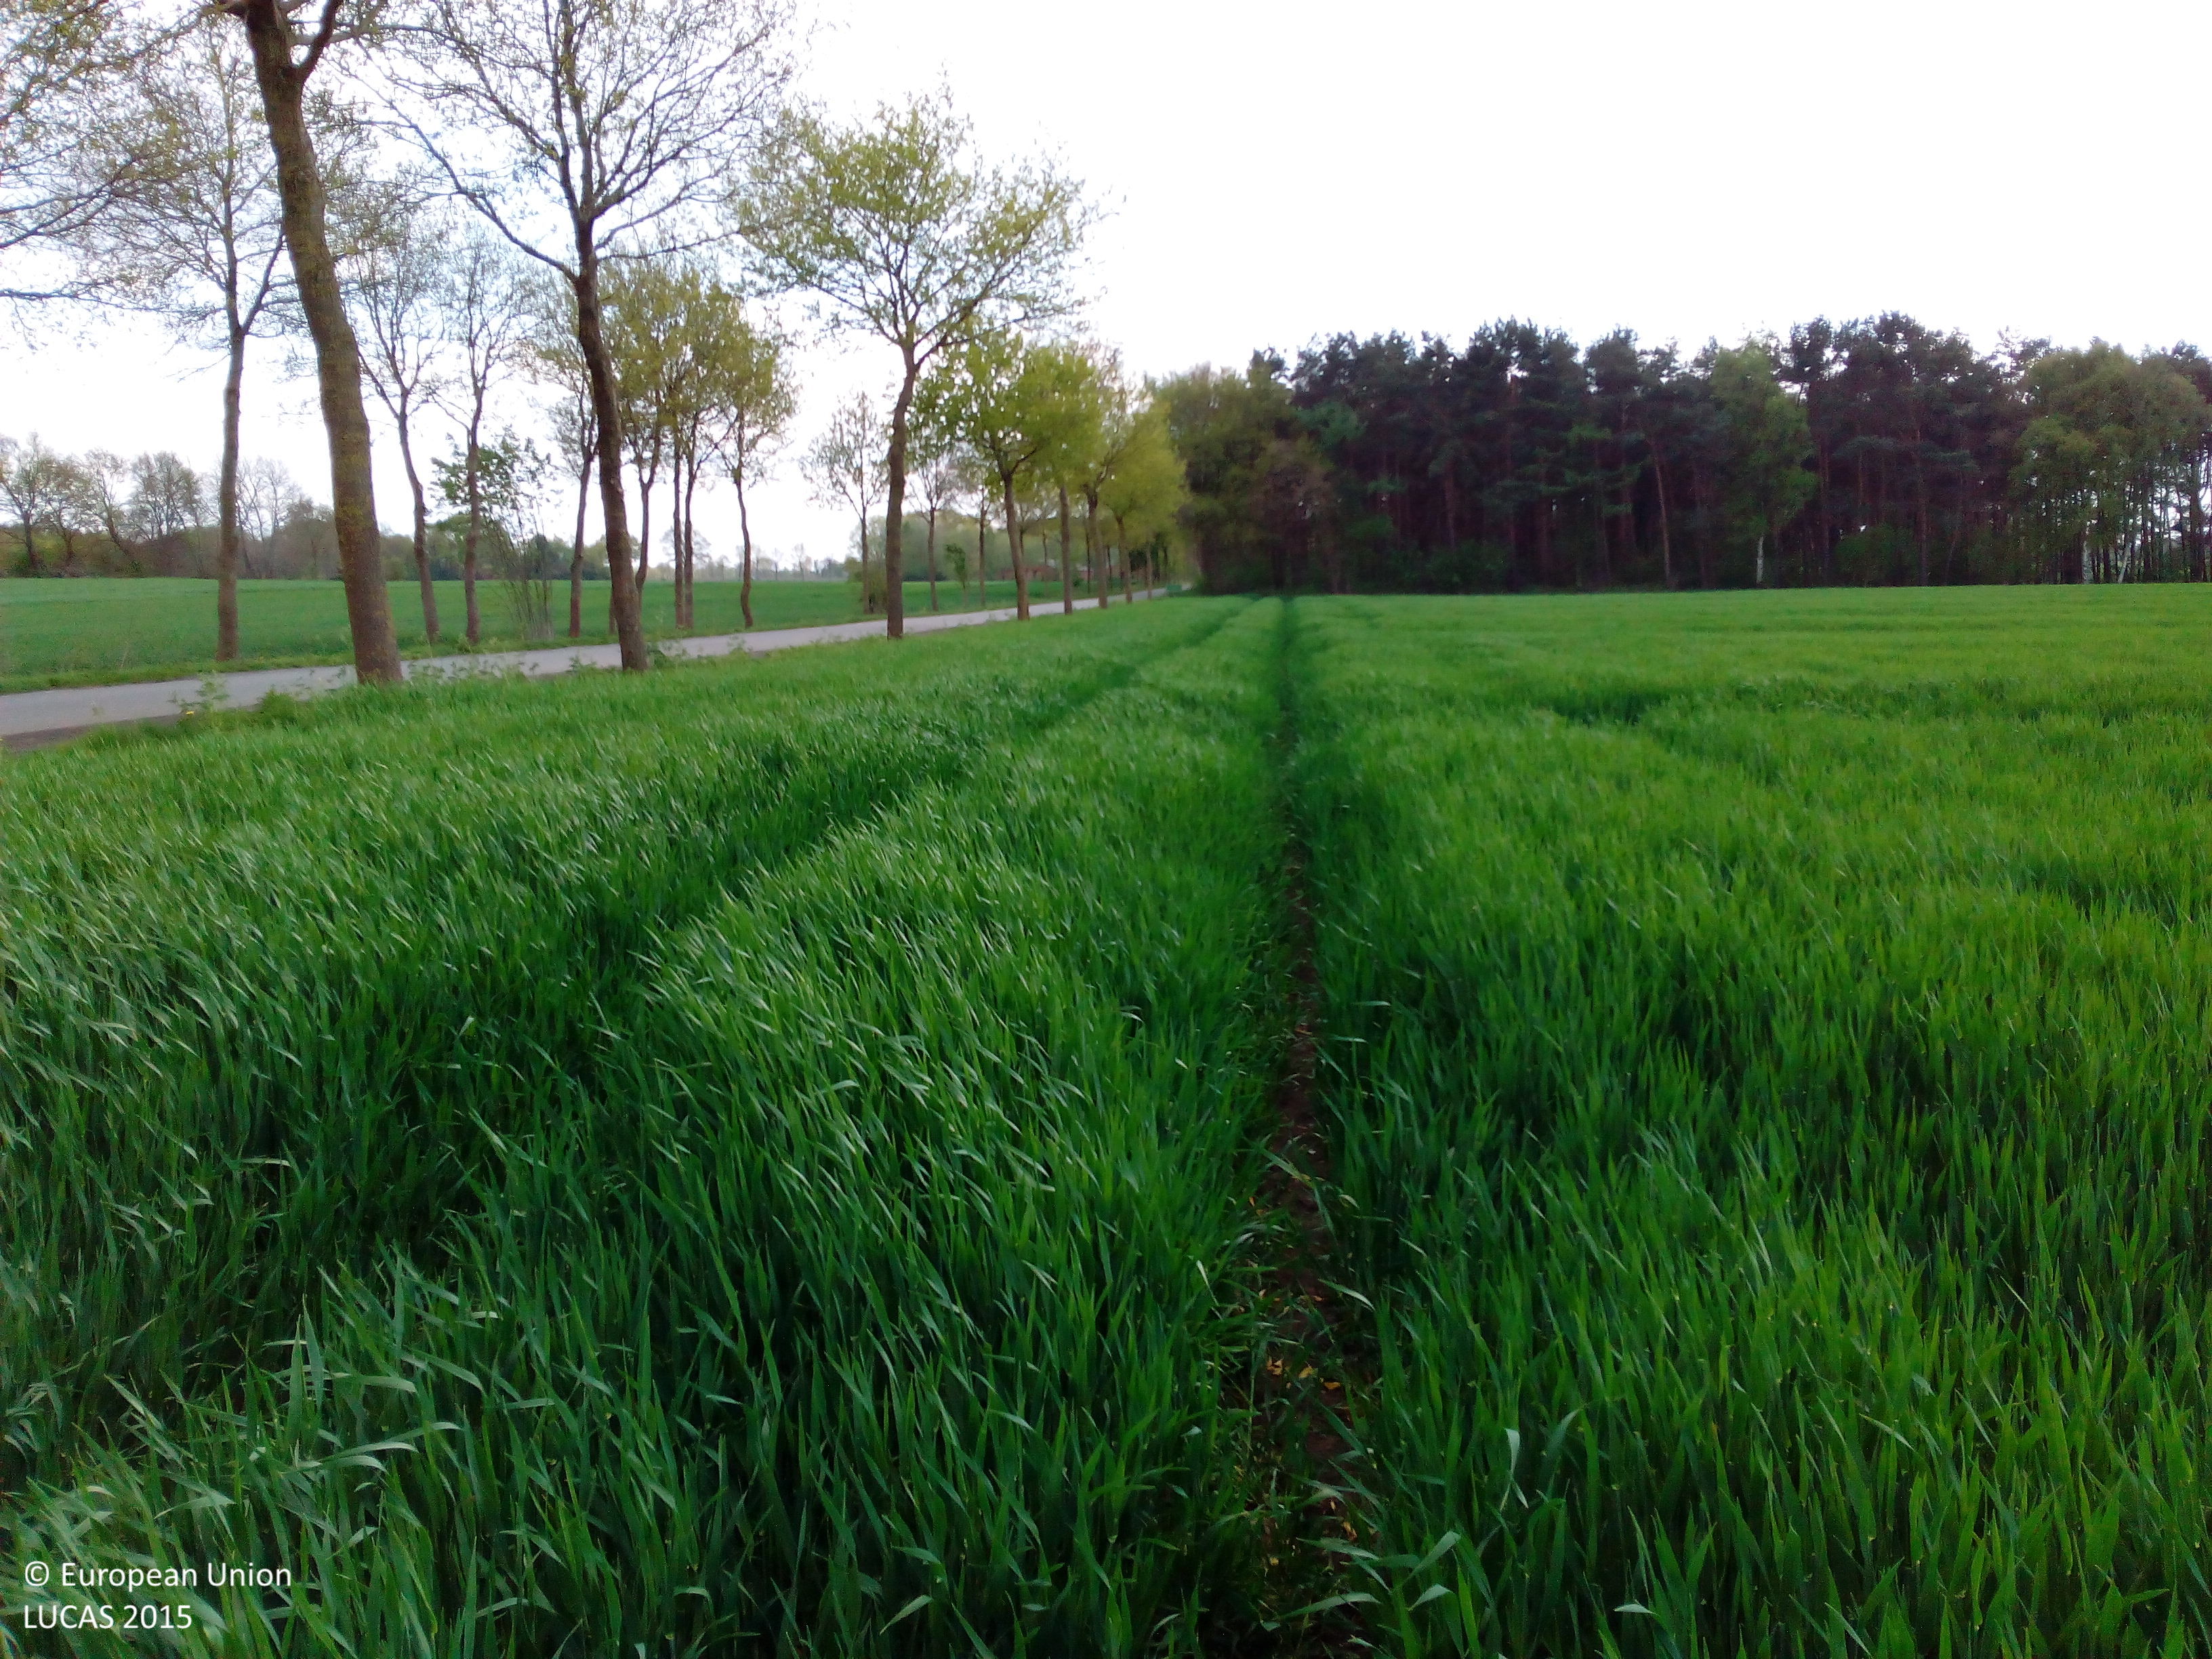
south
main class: Cropland
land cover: Barley
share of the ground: > 75 %
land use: Agriculture (excluding fallow land and kitchen gardens)
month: May
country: DE
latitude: 52.8640
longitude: 7.9953
